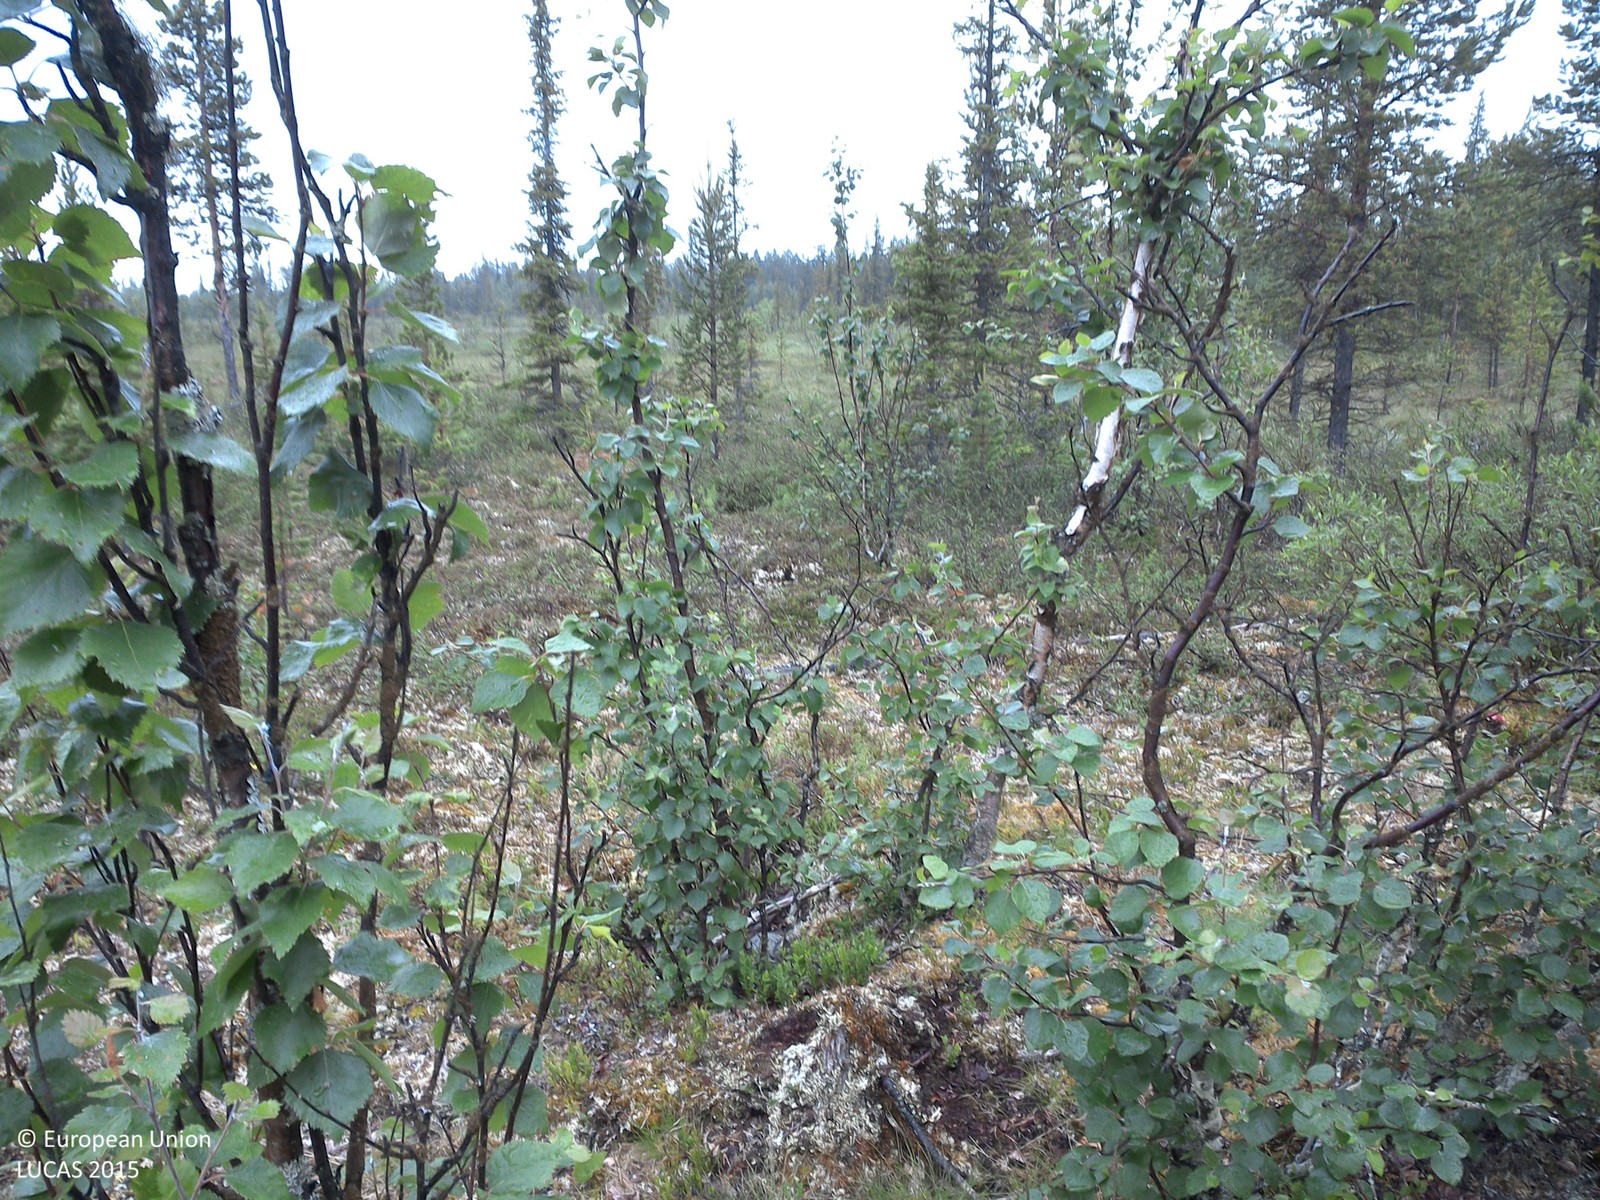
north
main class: Woodland
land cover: Pine dominated coniferous woodland
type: boreal forest
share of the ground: 10 - 25 %
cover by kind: shrubs 50 %, lichens and mosses 35 %, coniferous forest trees 15 %
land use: Forestry
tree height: > 5 m
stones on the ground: 25 - 50 %
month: July
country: SE
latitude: 67.8333
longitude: 20.5090
